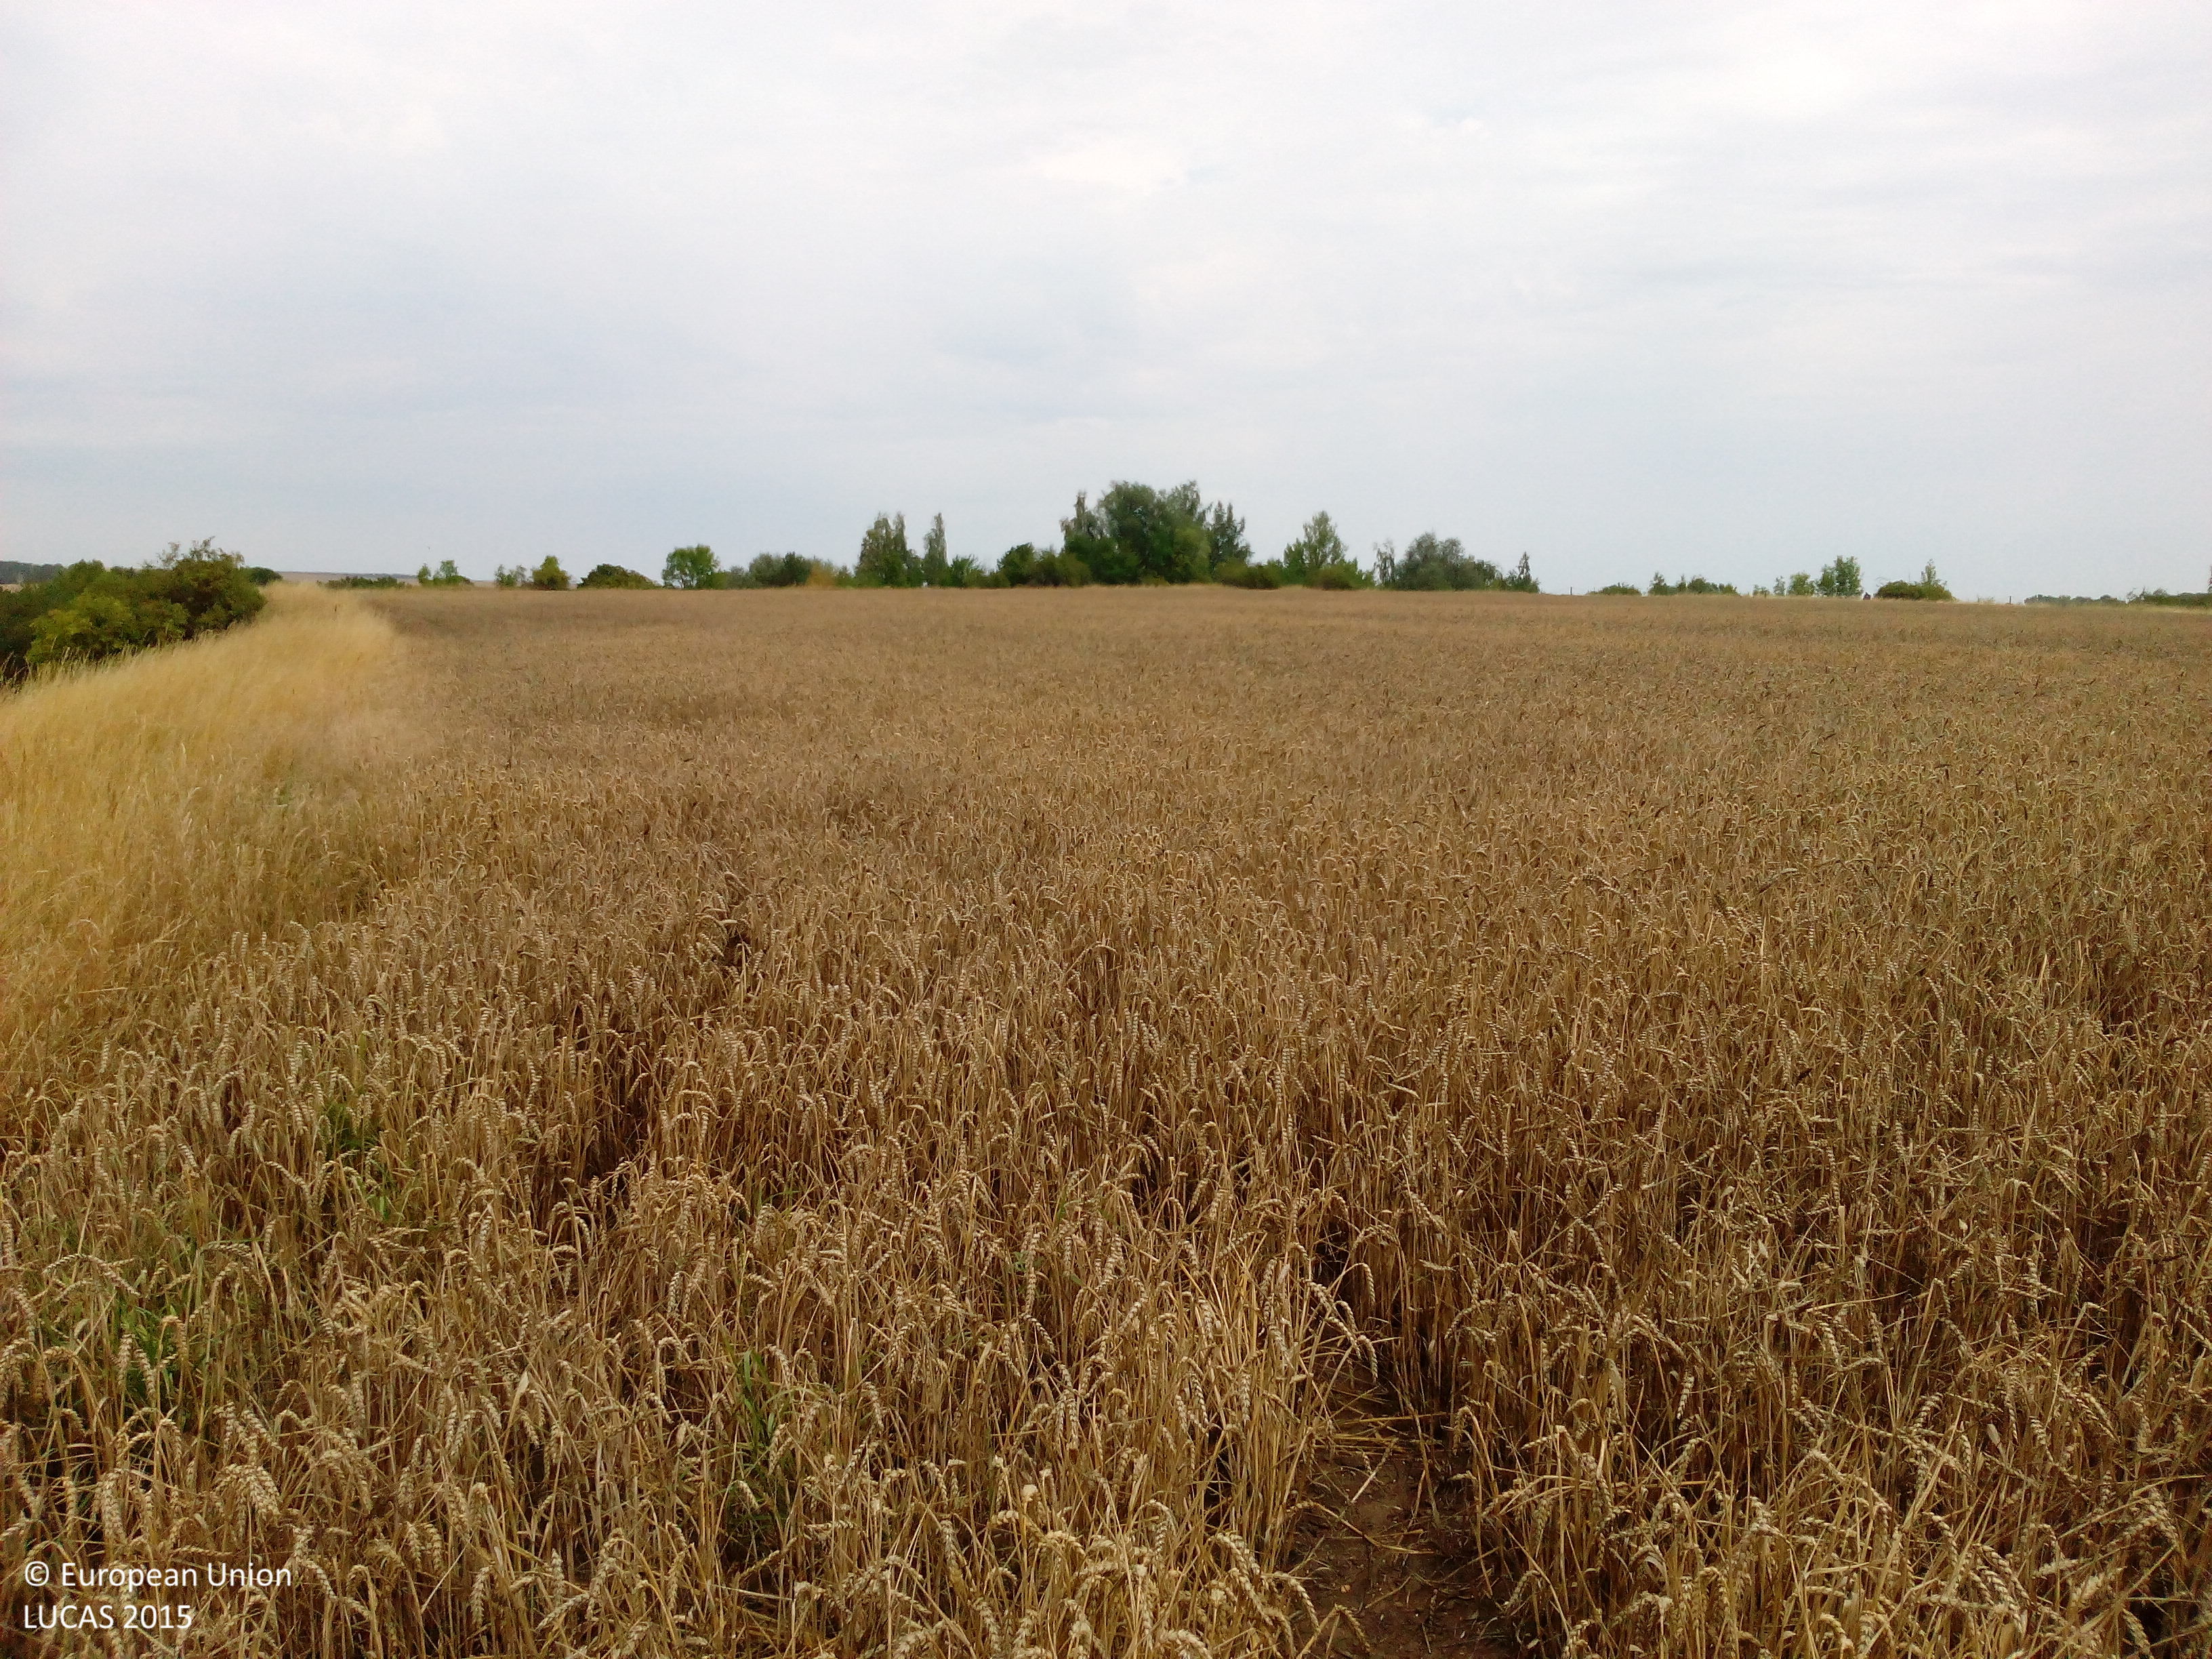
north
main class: Cropland
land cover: Common wheat
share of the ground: > 75 %
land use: Agriculture (excluding fallow land and kitchen gardens)
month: August
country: DE
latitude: 51.9228
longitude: 11.1193
